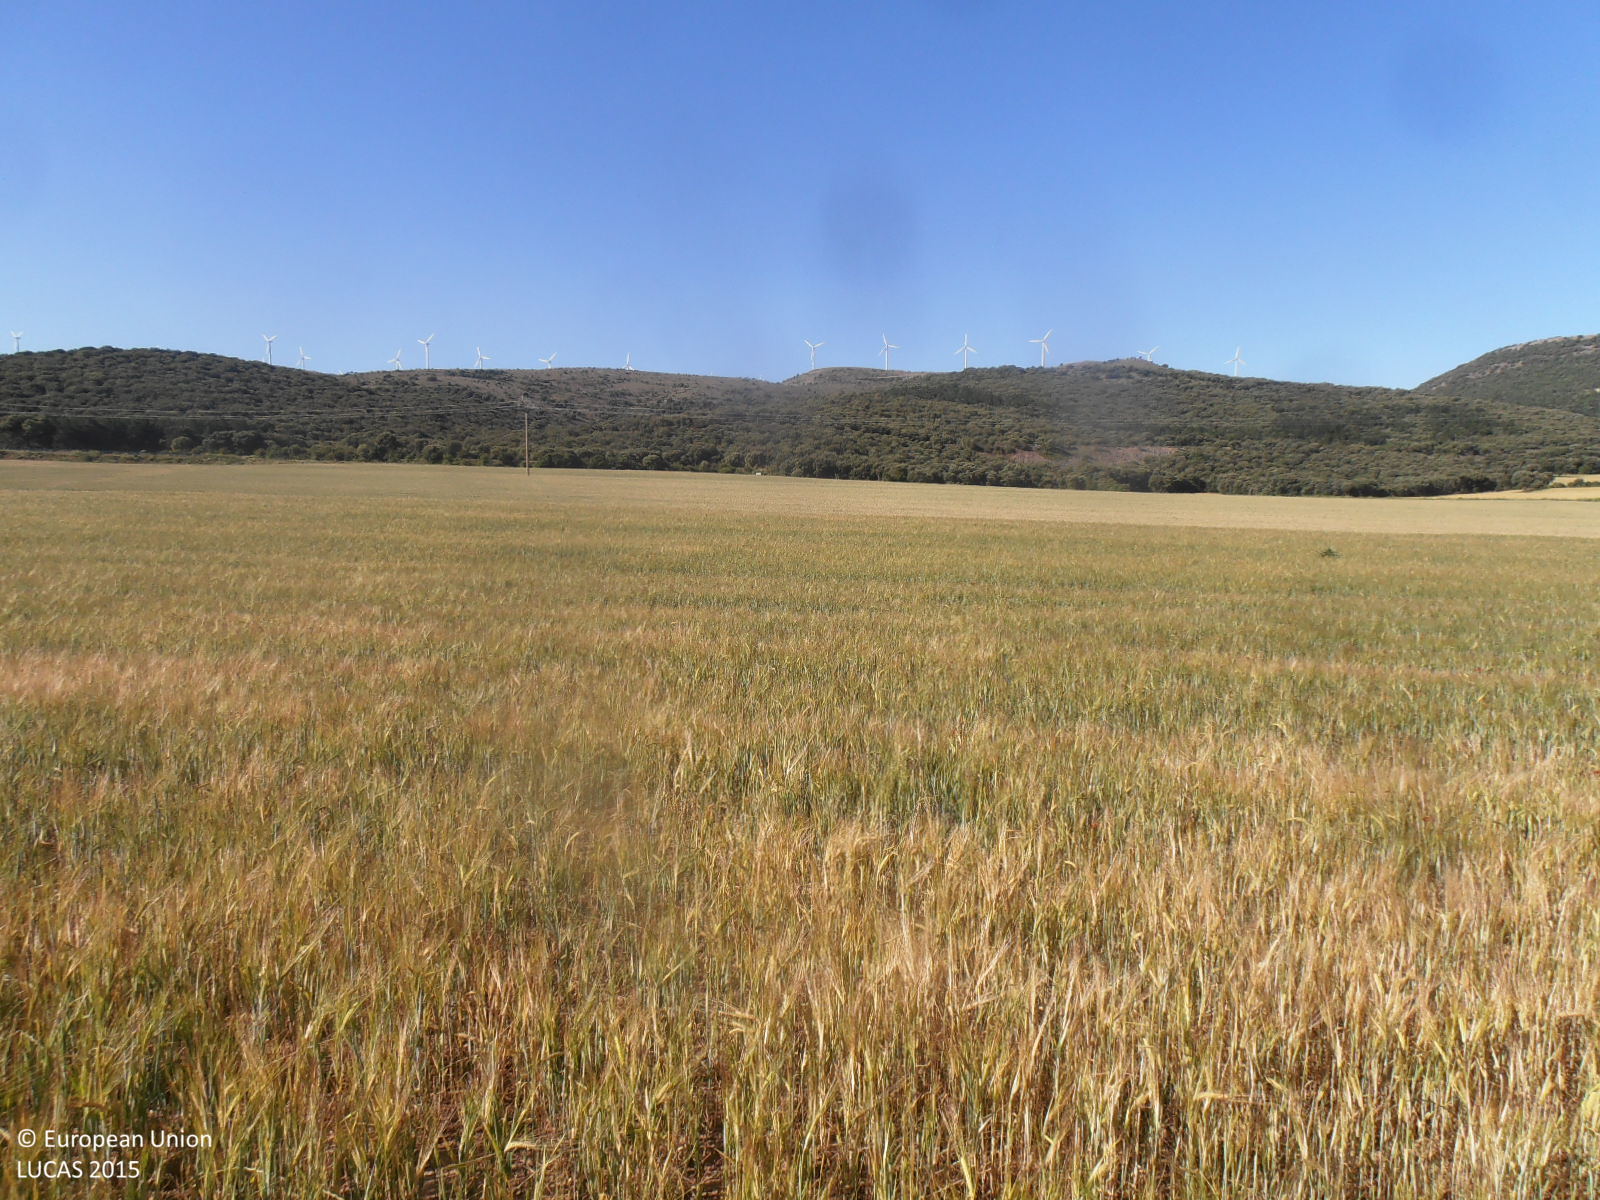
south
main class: Cropland
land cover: Barley
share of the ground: > 75 %
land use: Agriculture (excluding fallow land and kitchen gardens)
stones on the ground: < 10 %
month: June
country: ES
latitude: 41.7883
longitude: -2.0303
